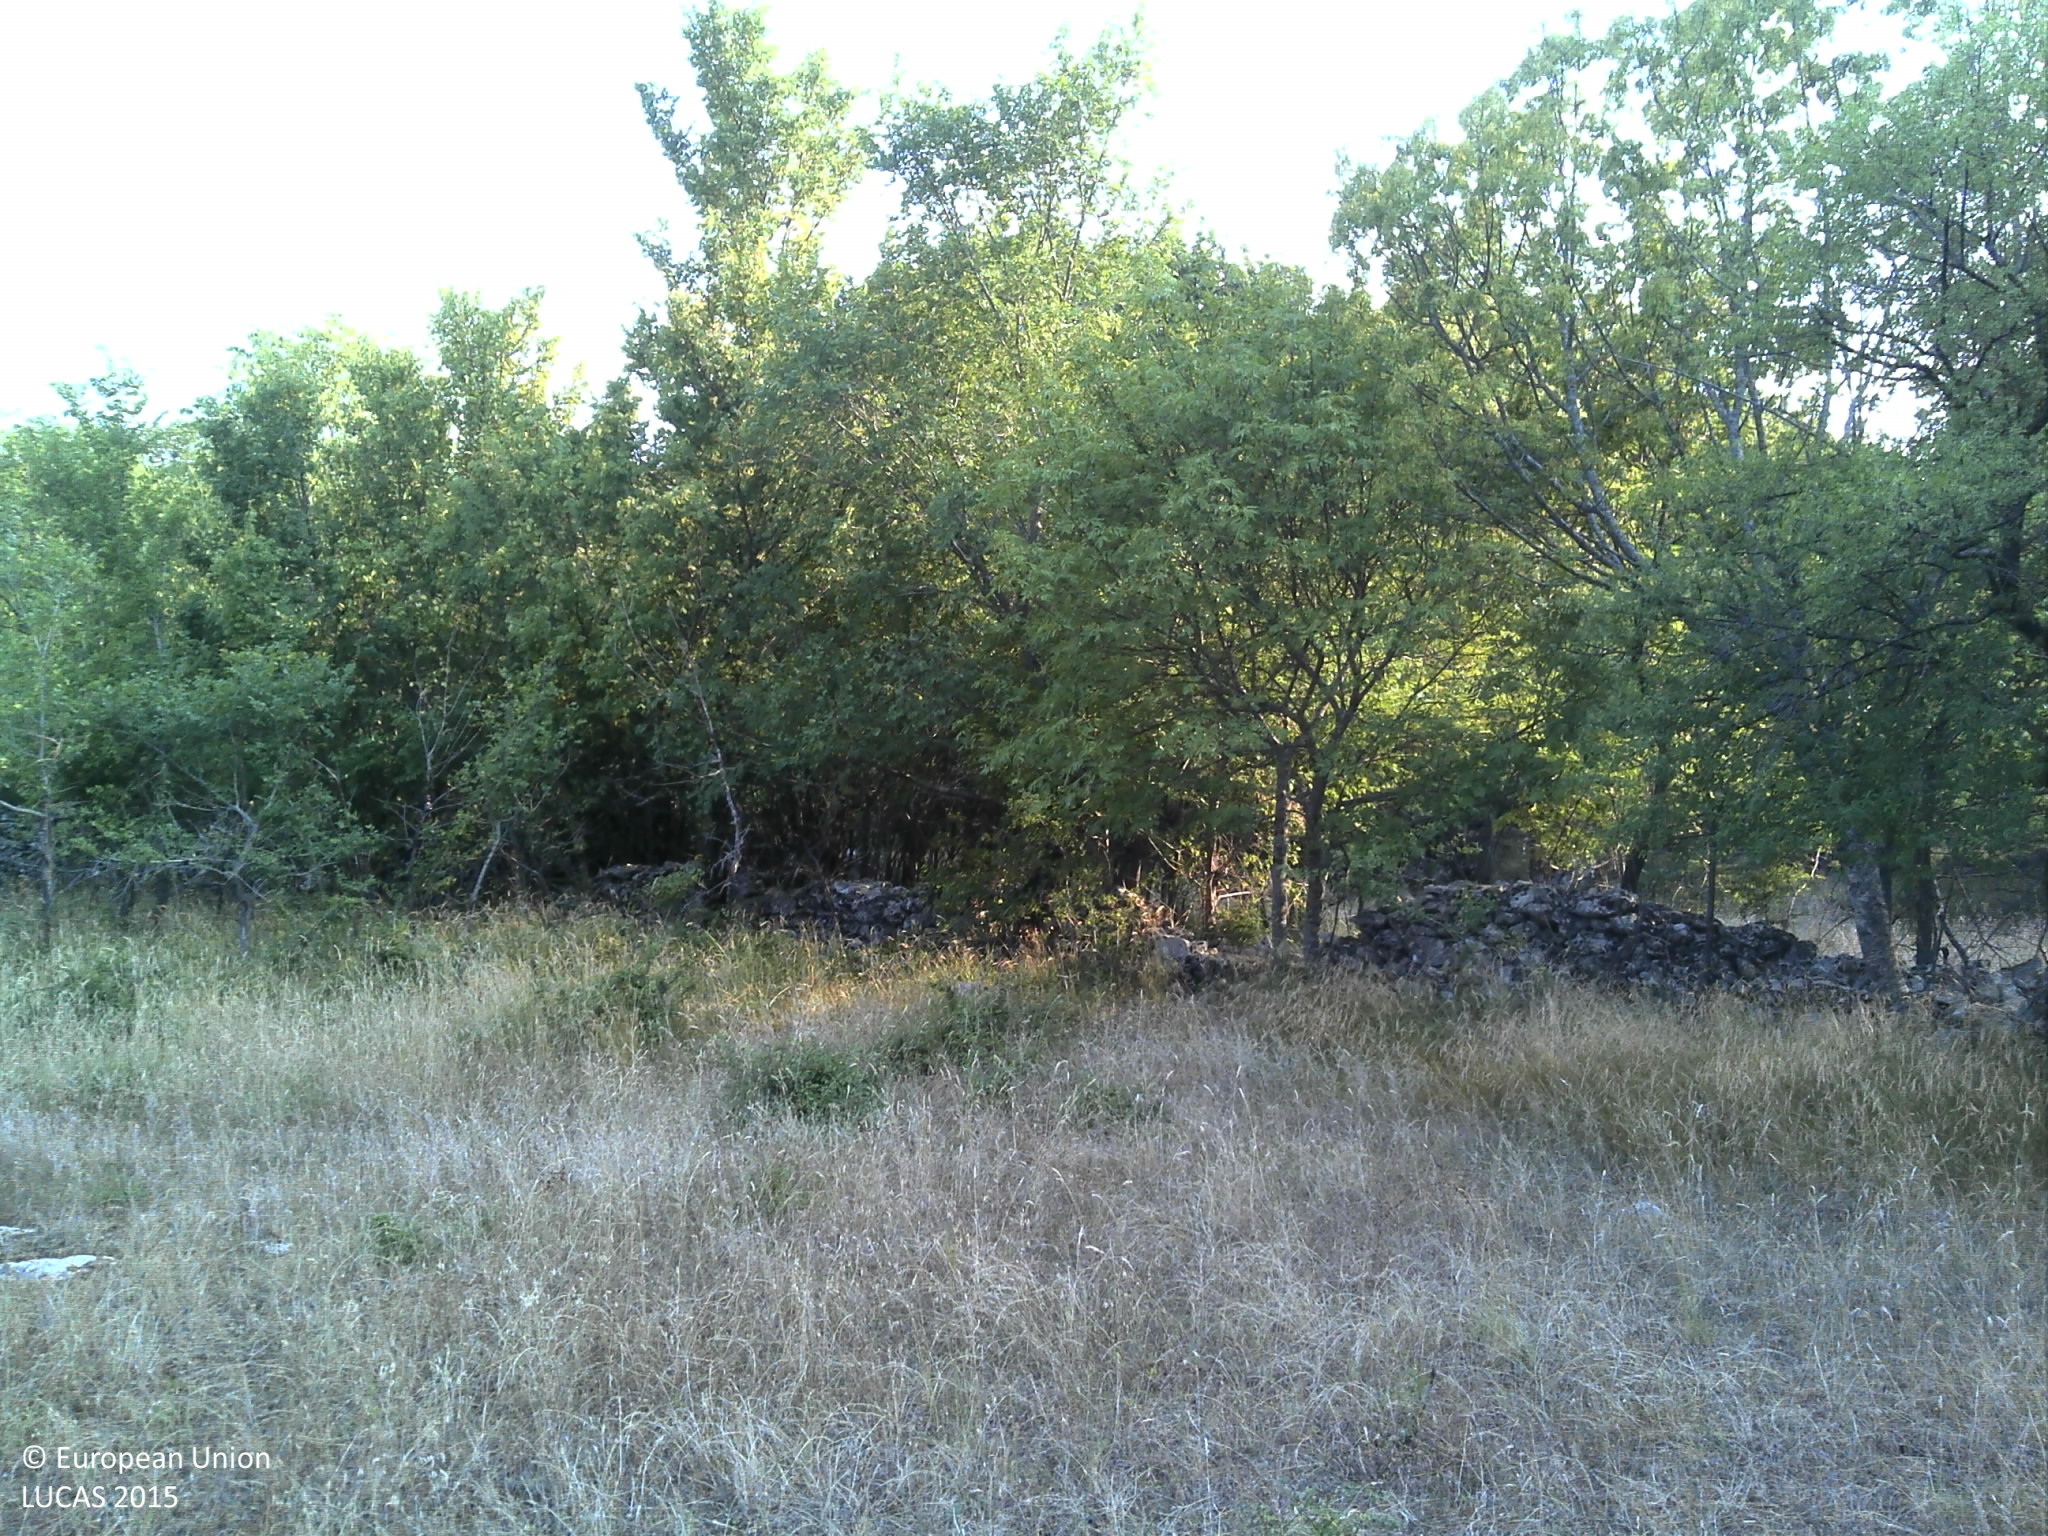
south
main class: Grassland
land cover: Grassland without tree/shrub cover
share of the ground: > 75 %
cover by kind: herbaceous plants 95 %, shrubs 5 %
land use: Semi-natural and natural areas not in use
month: July
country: HR
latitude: 43.9445
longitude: 16.2593
